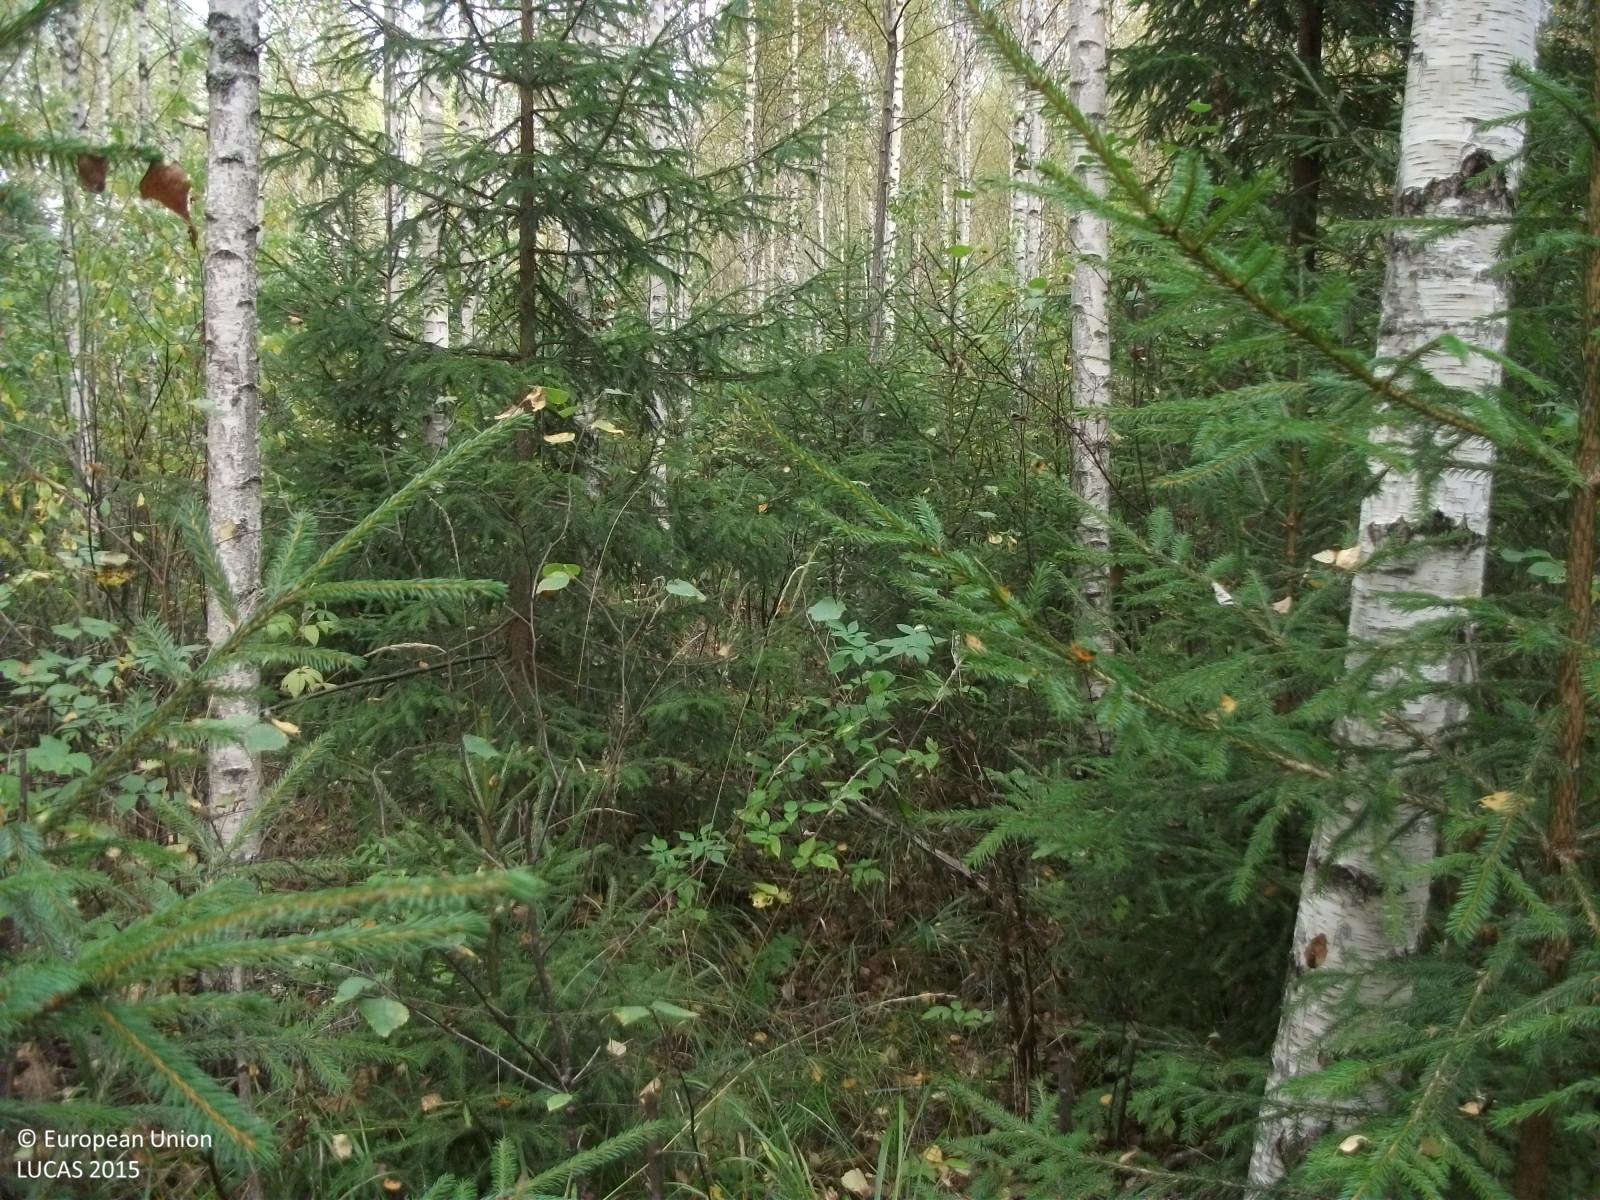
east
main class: Woodland
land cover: Spruce dominated mixed woodland
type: hemiboreal forest and nemoral coniferous forest and mixed broadleaved-coniferous forest
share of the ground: > 75 %
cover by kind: broadleaved forest trees 50 %, coniferous forest trees 30 %, herbaceous plants 10 %, shrubs 5 %, unconsolidated bare surface 5 %
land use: Forestry
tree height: > 5 m
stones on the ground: < 10 %
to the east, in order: Spruce dominated mixed woodland; Spontaneously vegetated surfaces; Ditches and canals; Grass margins; Paved roads, cycling and walking lanes; Grass margins; Ditches and canals; Broadleaved woodland
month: September
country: LV
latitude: 57.7424
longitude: 24.7953
